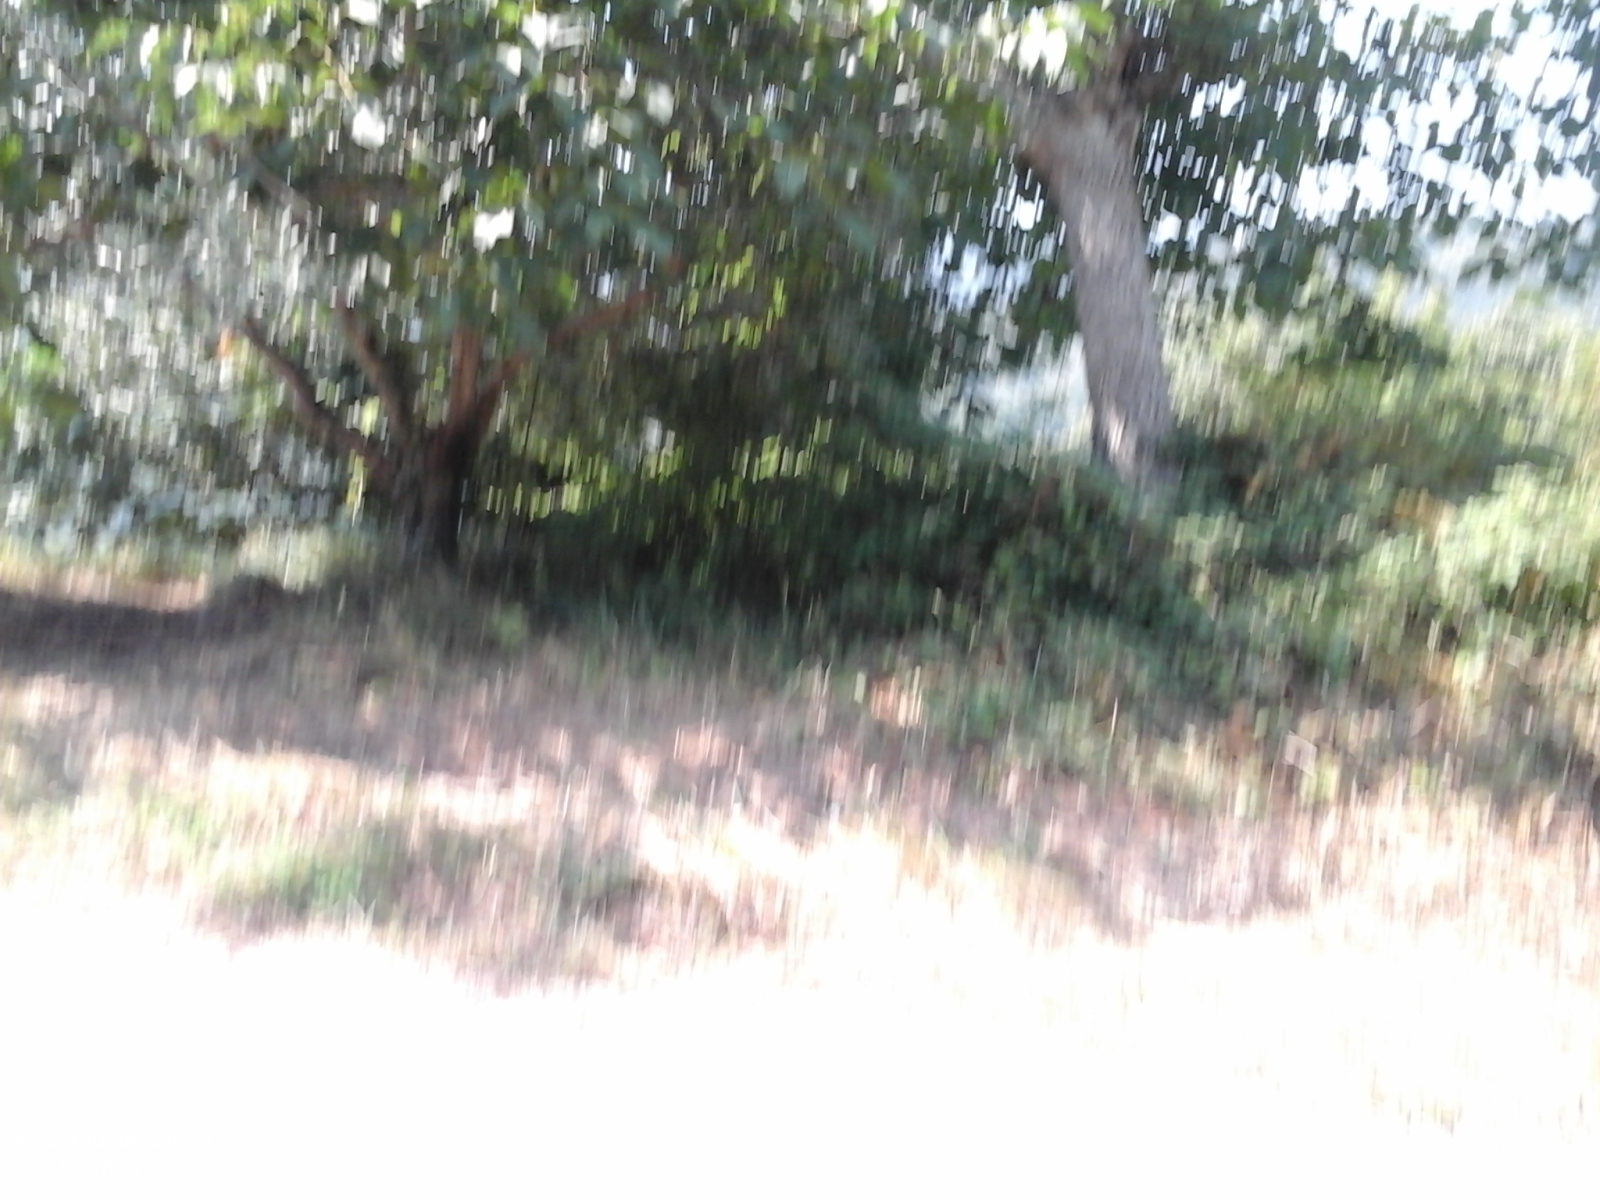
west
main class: Woodland
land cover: Broadleaved woodland
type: mesophytic deciduous forest
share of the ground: > 75 %
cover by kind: broadleaved forest trees 100 %
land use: Forestry
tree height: < 5 m
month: August
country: IT
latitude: 41.8861
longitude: 13.0139
